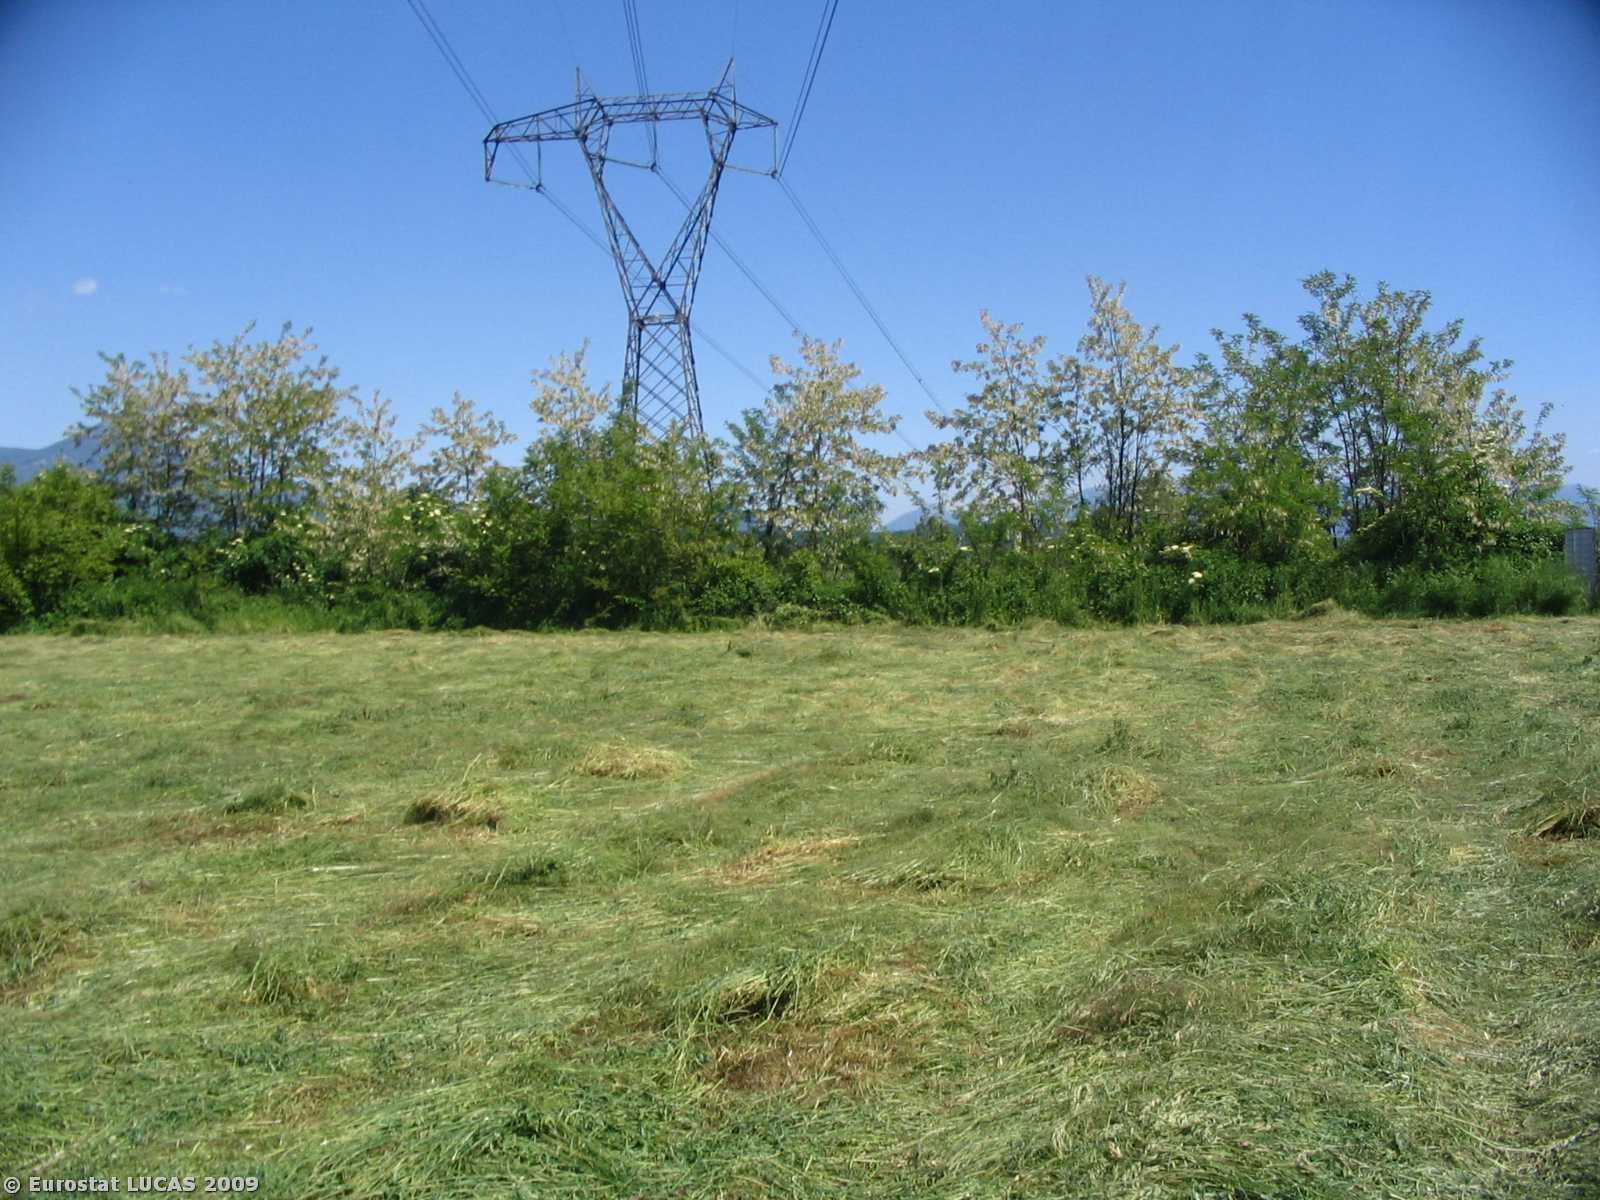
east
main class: Cropland
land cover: Lucerne
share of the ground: < 10 %
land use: Agriculture (excluding fallow land and kitchen gardens)
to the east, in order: Lucerne; Electric lines; Lucerne; Abandoned hedges; Tracks; Abandoned hedges; Mixed cereals for fodder
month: May
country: IT
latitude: 41.2943
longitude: 14.3423
